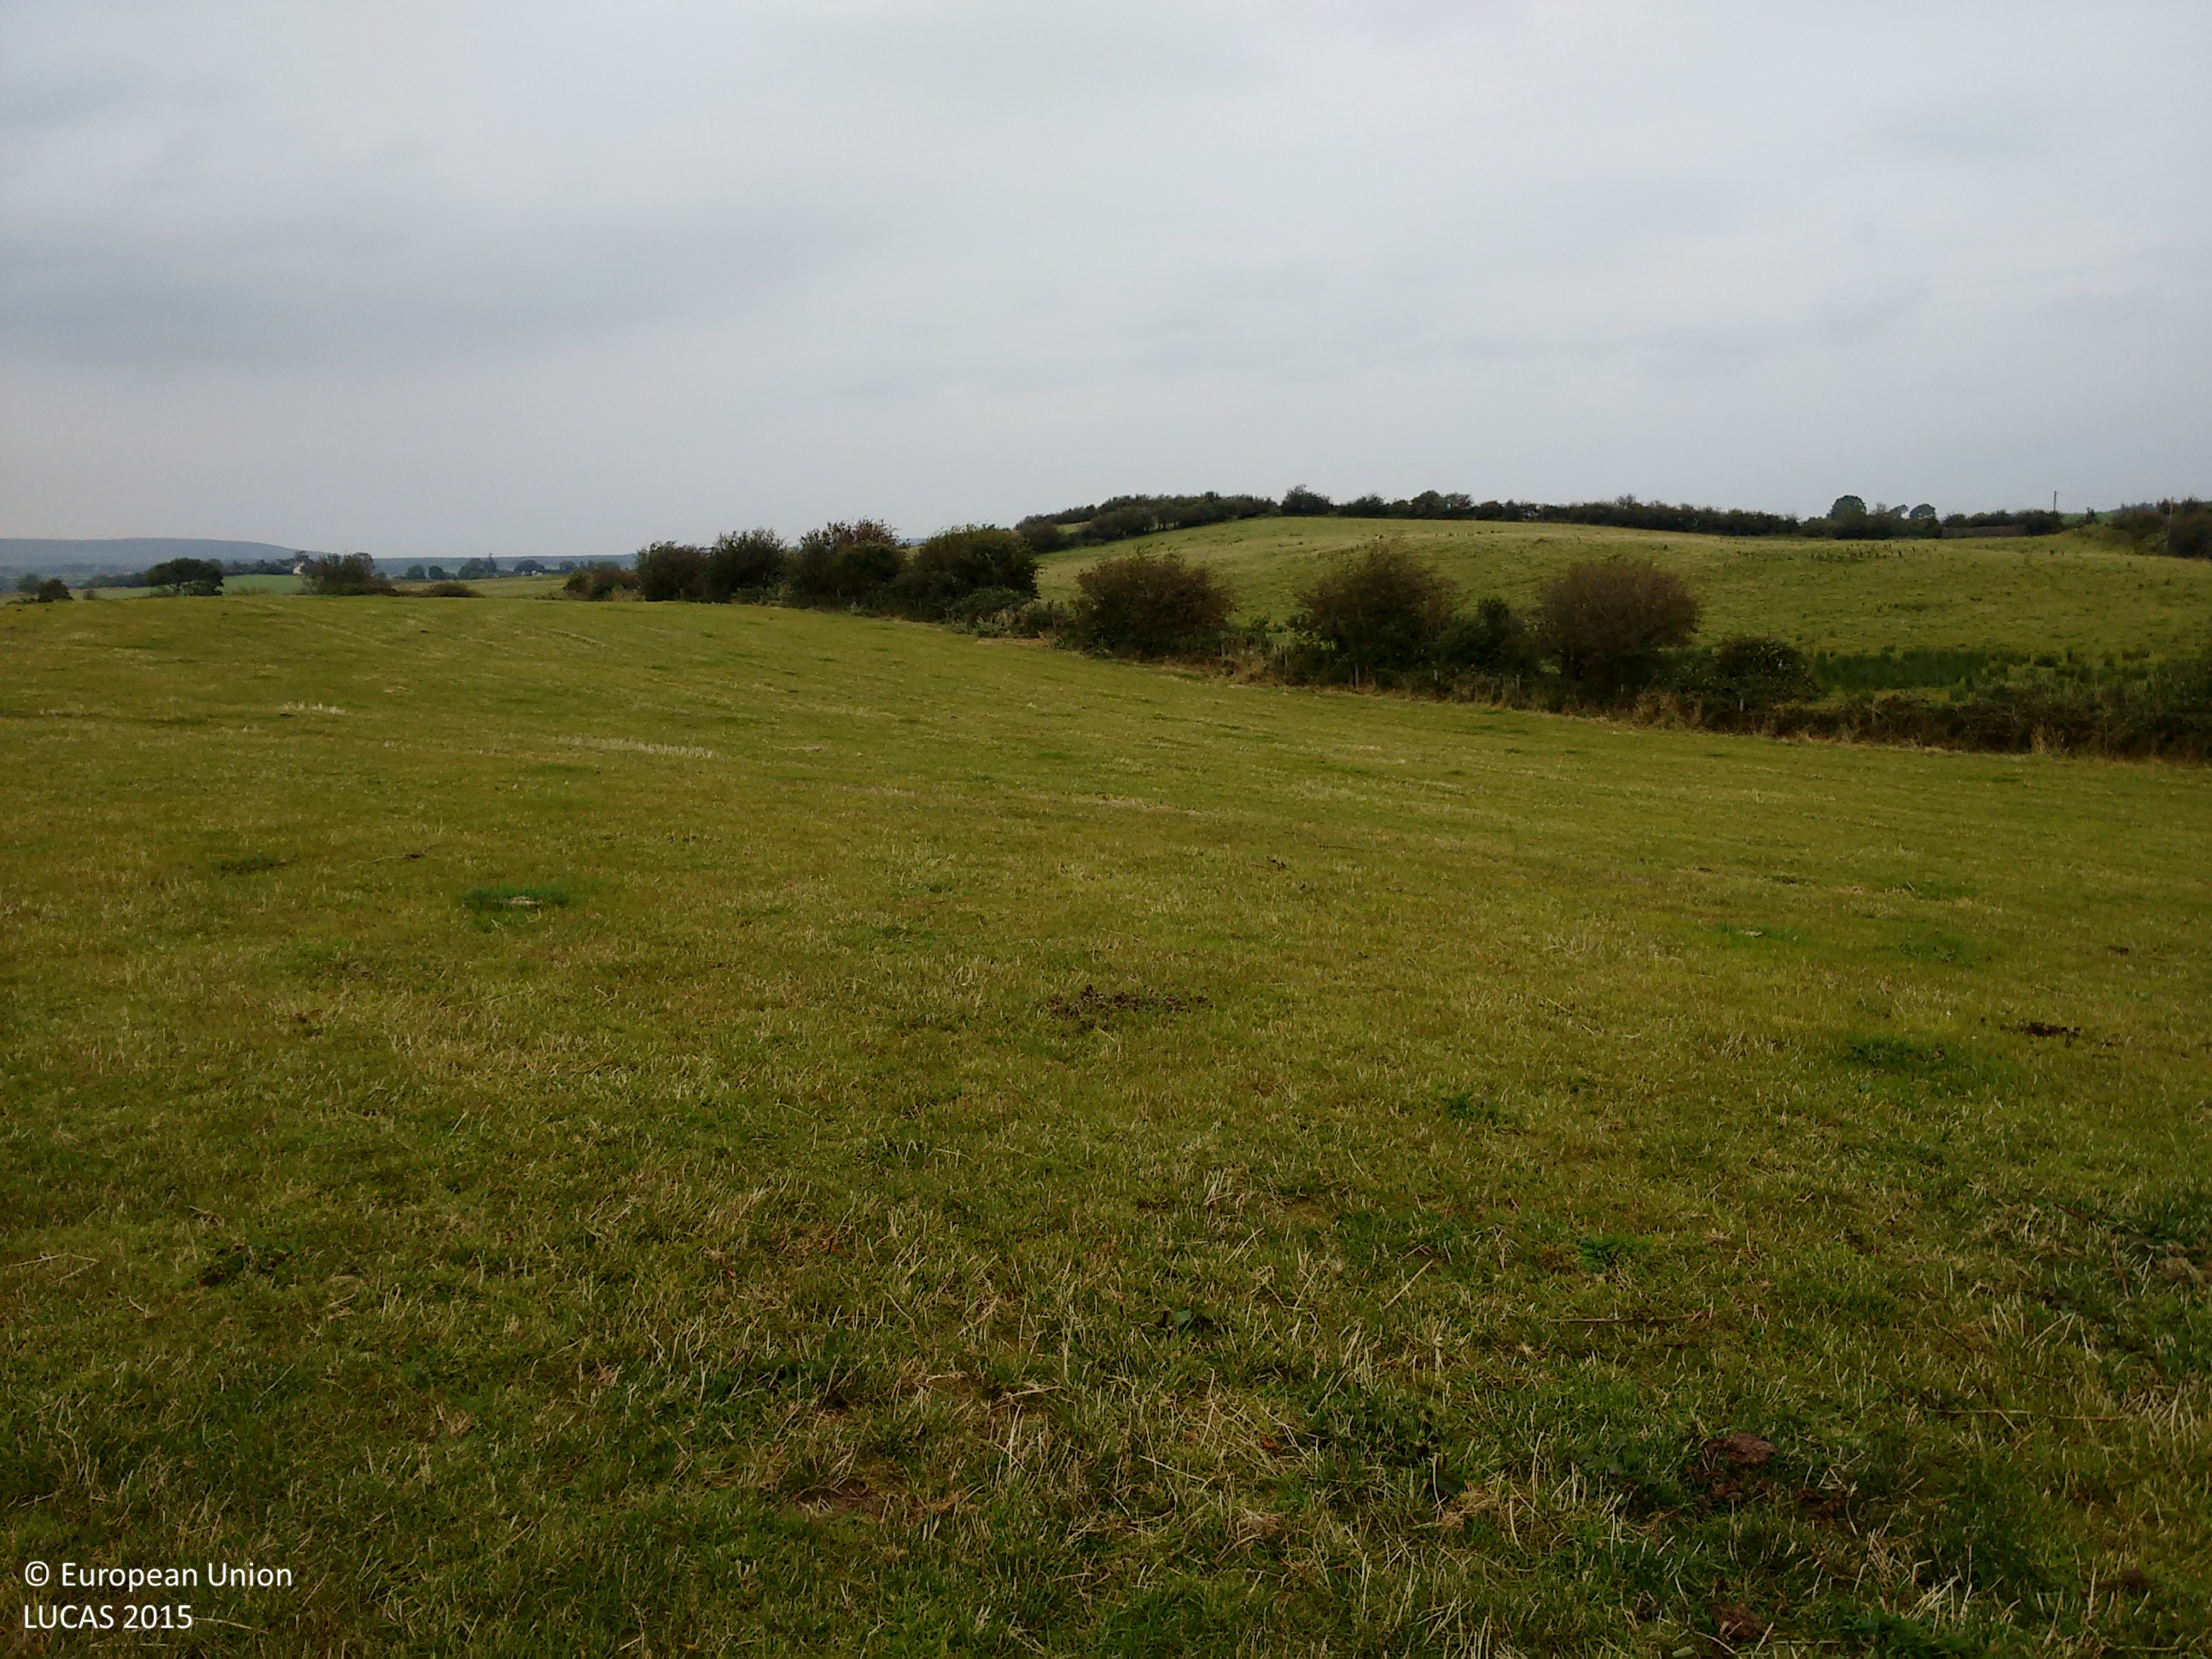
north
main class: Grassland
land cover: Grassland without tree/shrub cover
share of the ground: > 75 %
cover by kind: herbaceous plants 100 %
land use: Agriculture (excluding fallow land and kitchen gardens)
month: September
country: IE
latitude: 54.1977
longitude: -9.3073
